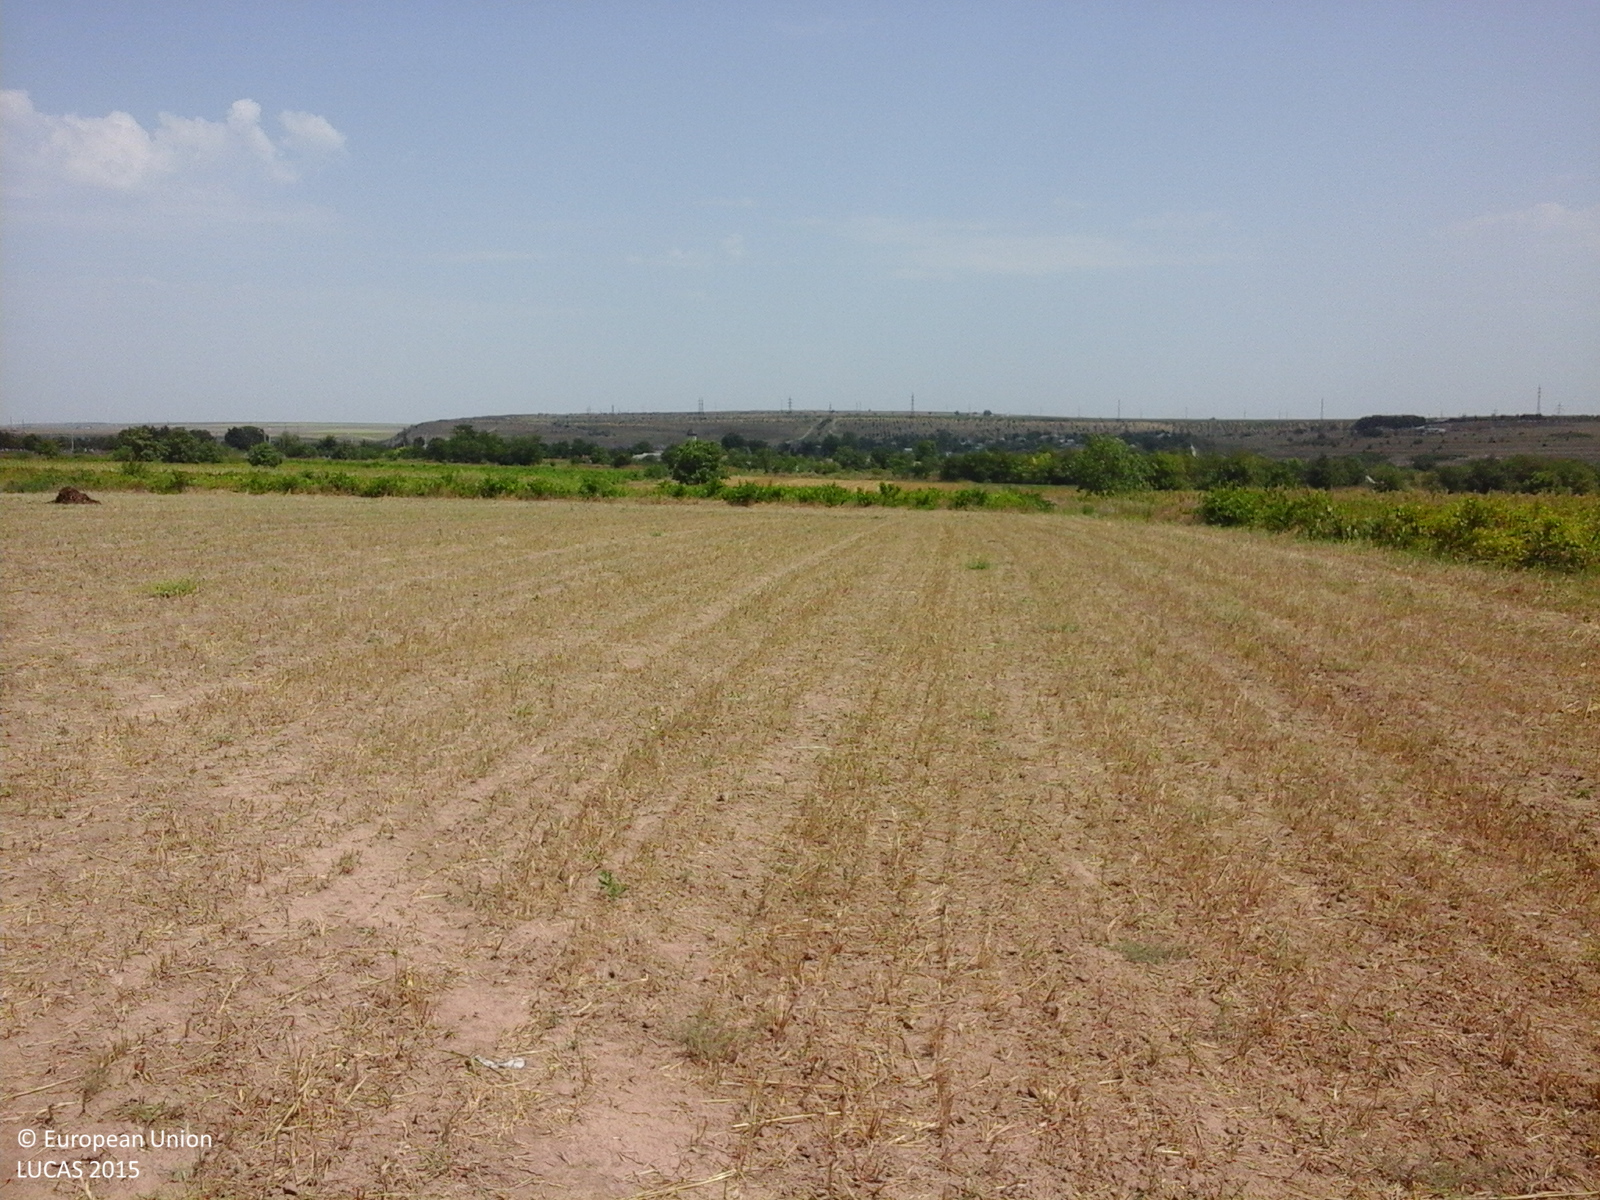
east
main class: Cropland
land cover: Oats
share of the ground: 25 - 50 %
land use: Agriculture (excluding fallow land and kitchen gardens)
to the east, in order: Oats; Vineyards; Common wheat
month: August
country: RO
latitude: 44.2804
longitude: 28.1661
